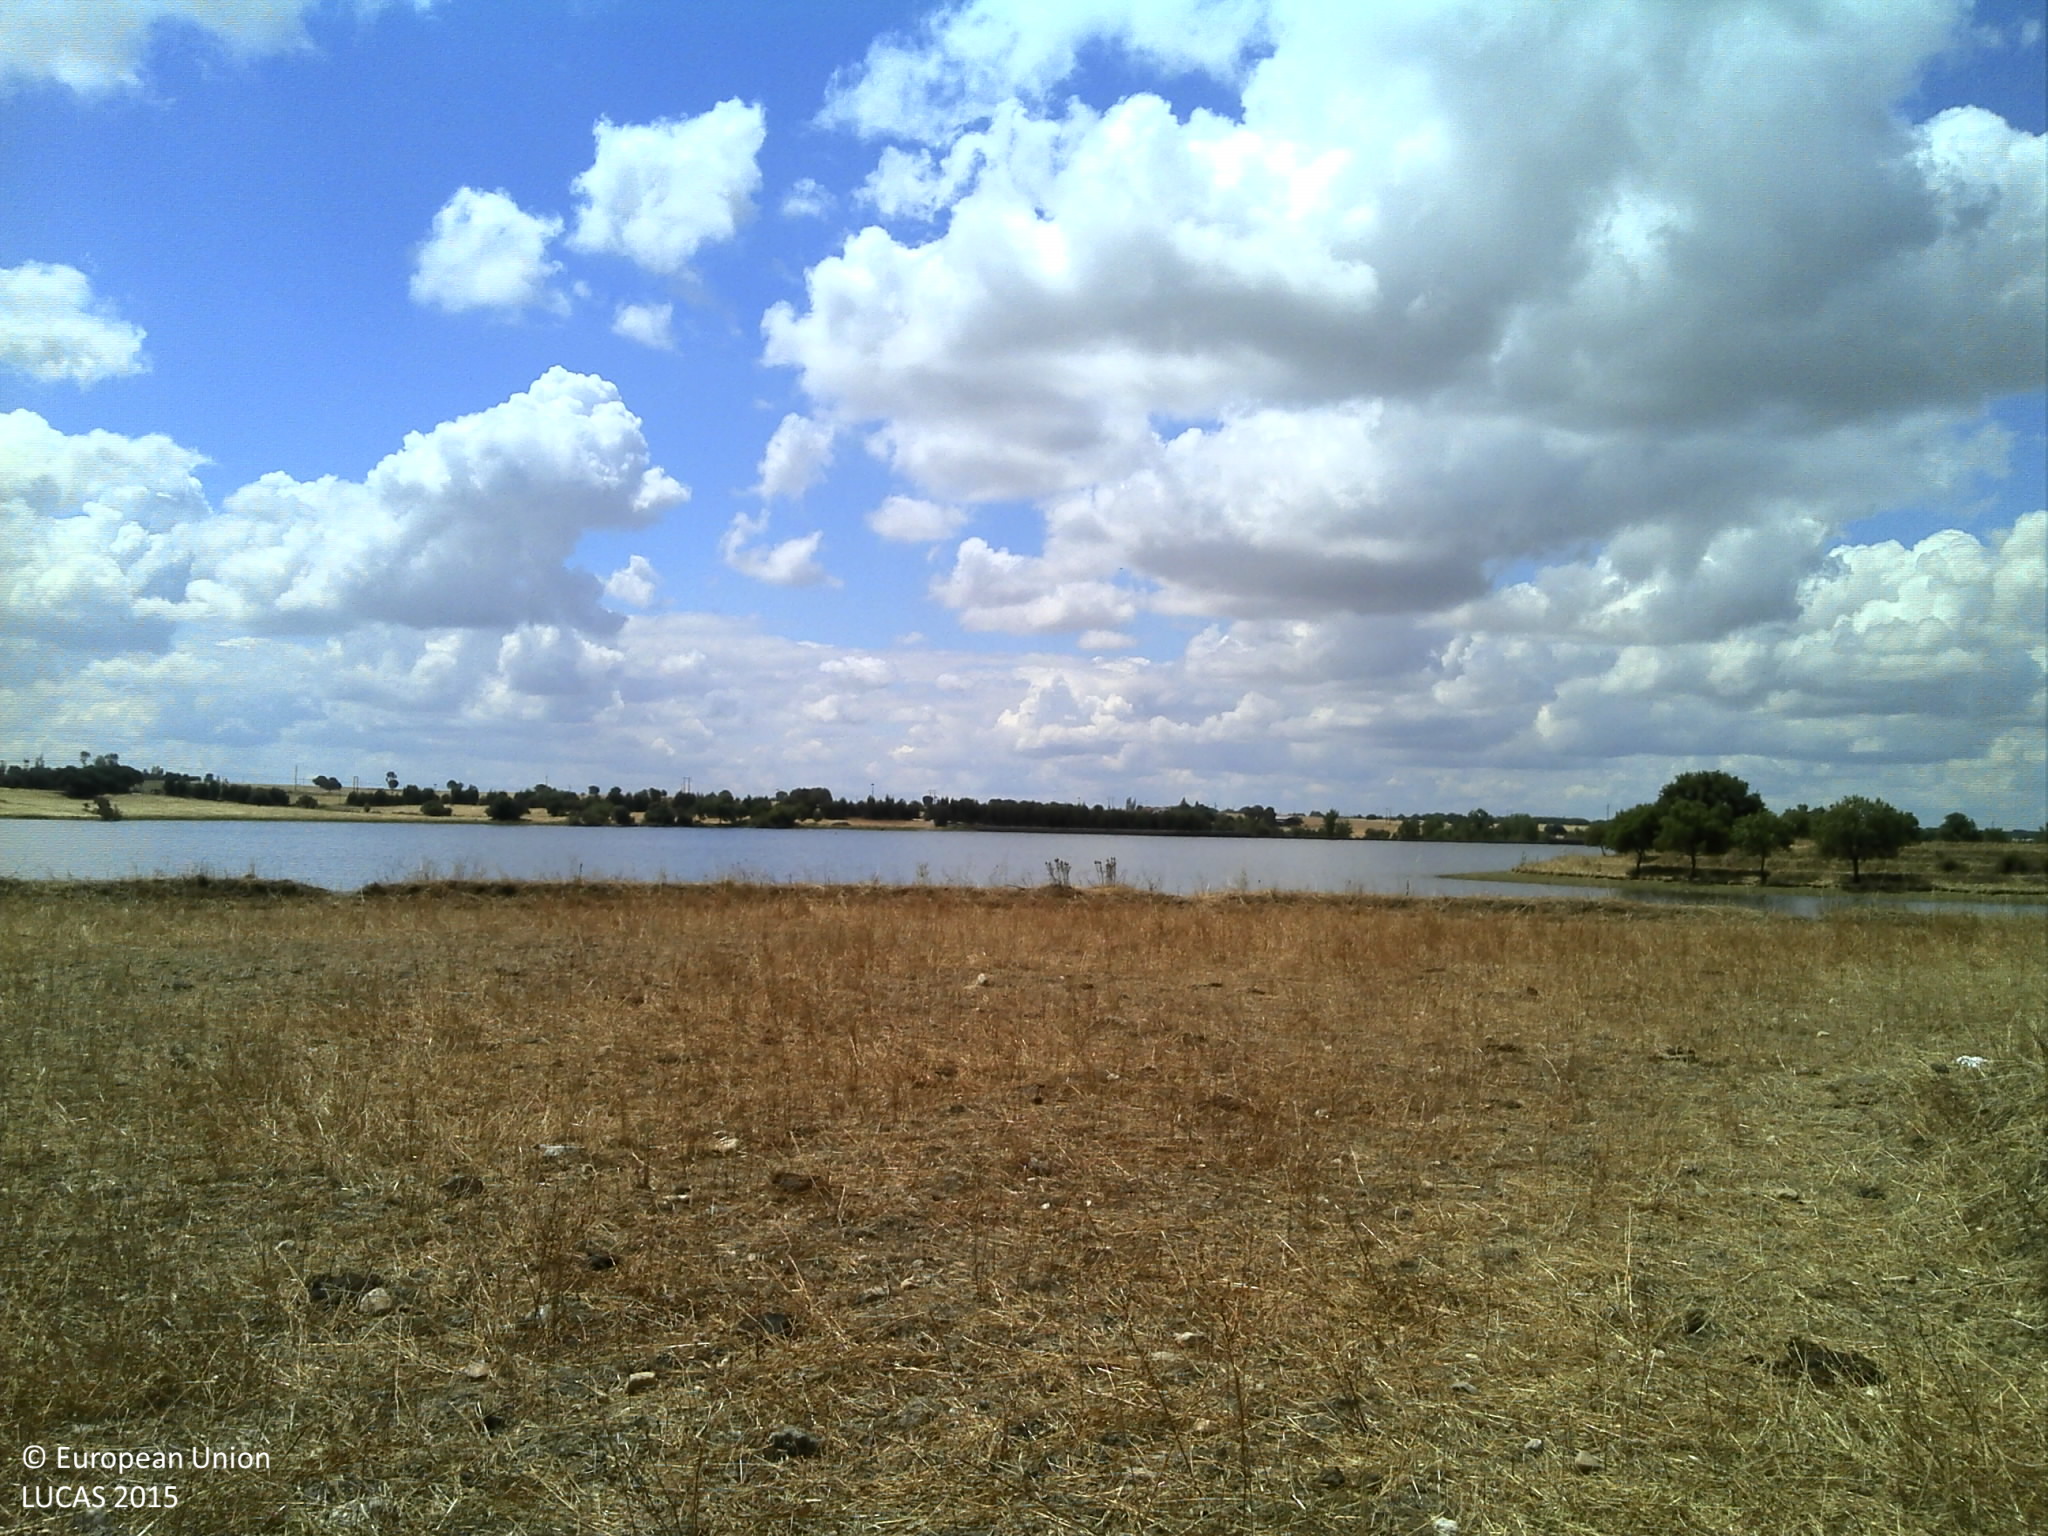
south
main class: Grassland
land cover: Grassland without tree/shrub cover
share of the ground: 25 - 50 %
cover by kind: unconsolidated bare surface 65 %, herbaceous plants 35 %
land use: Agriculture (excluding fallow land and kitchen gardens)
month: June
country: PT
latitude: 38.5066
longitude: -8.0337
